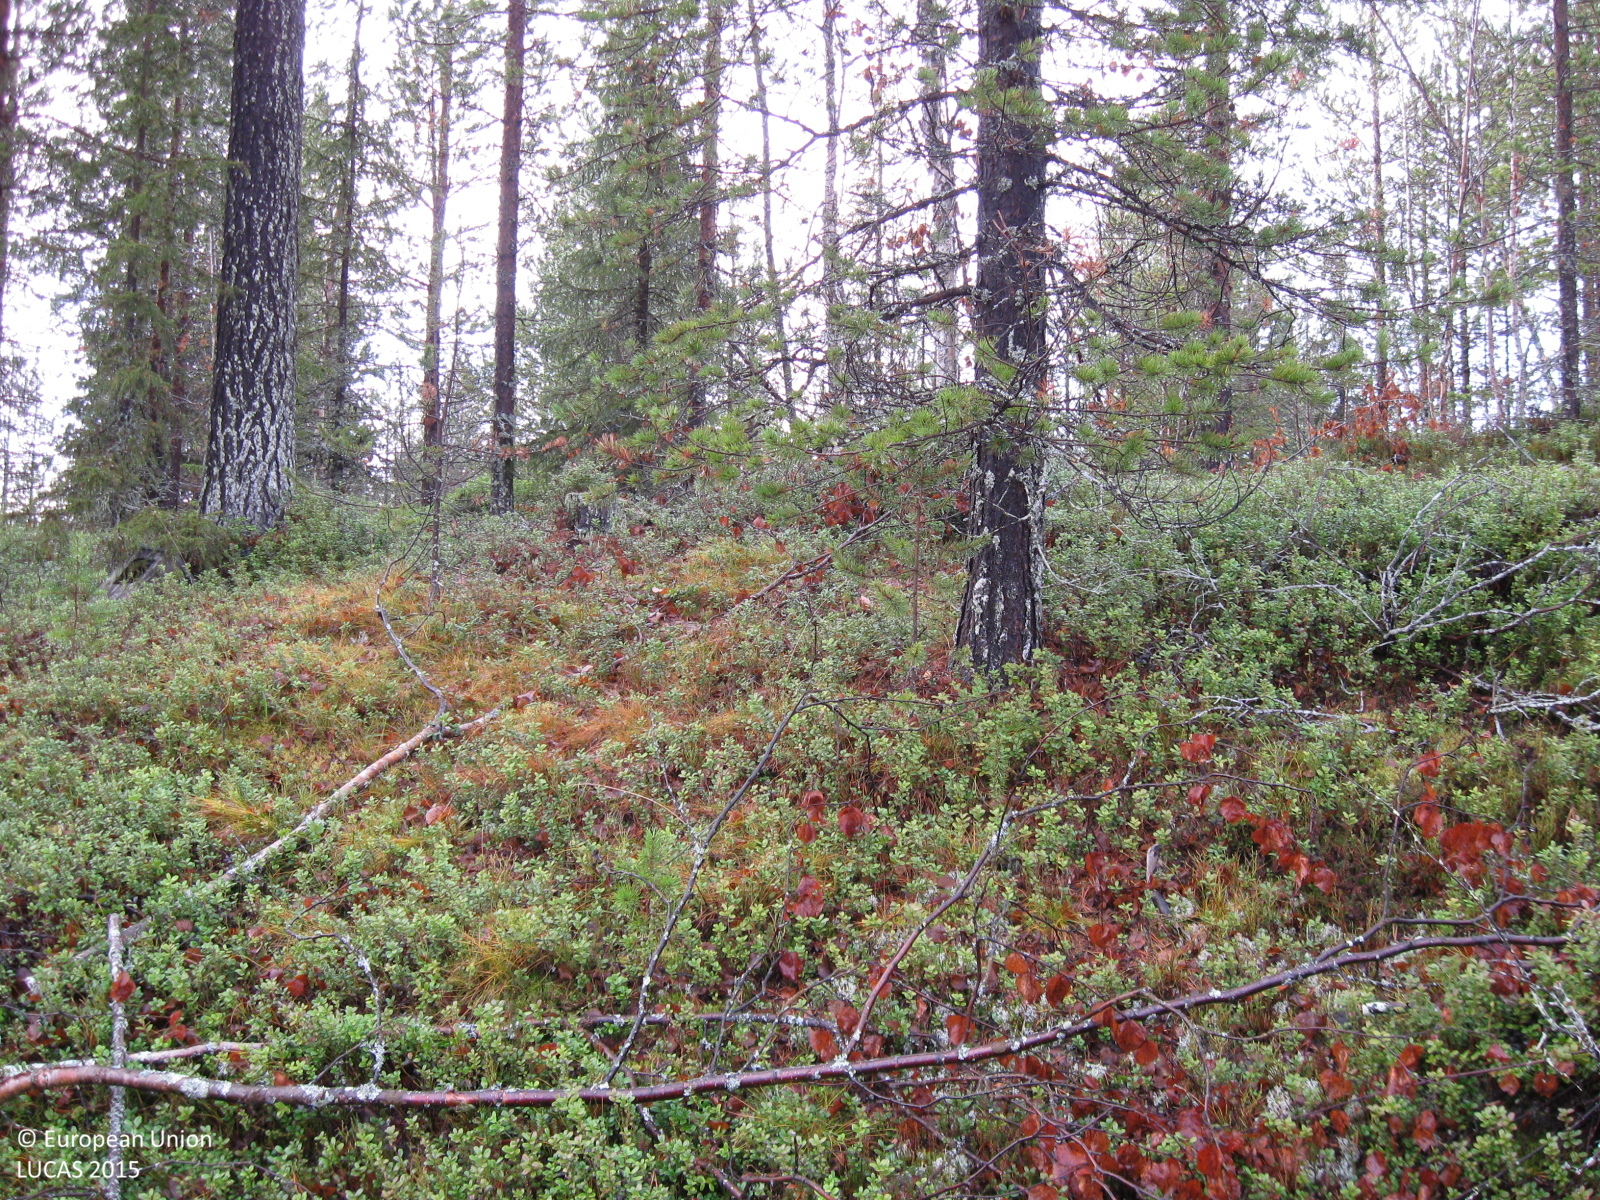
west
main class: Woodland
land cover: Pine dominated mixed woodland
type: boreal forest
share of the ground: 25 - 50 %
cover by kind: herbaceous plants 25 %, coniferous forest trees 20 %, broadleaved forest trees 20 %, shrubs 20 %, lichens and mosses 15 %
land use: Forestry
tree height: > 5 m
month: October
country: SE
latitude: 66.8289
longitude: 21.0466
